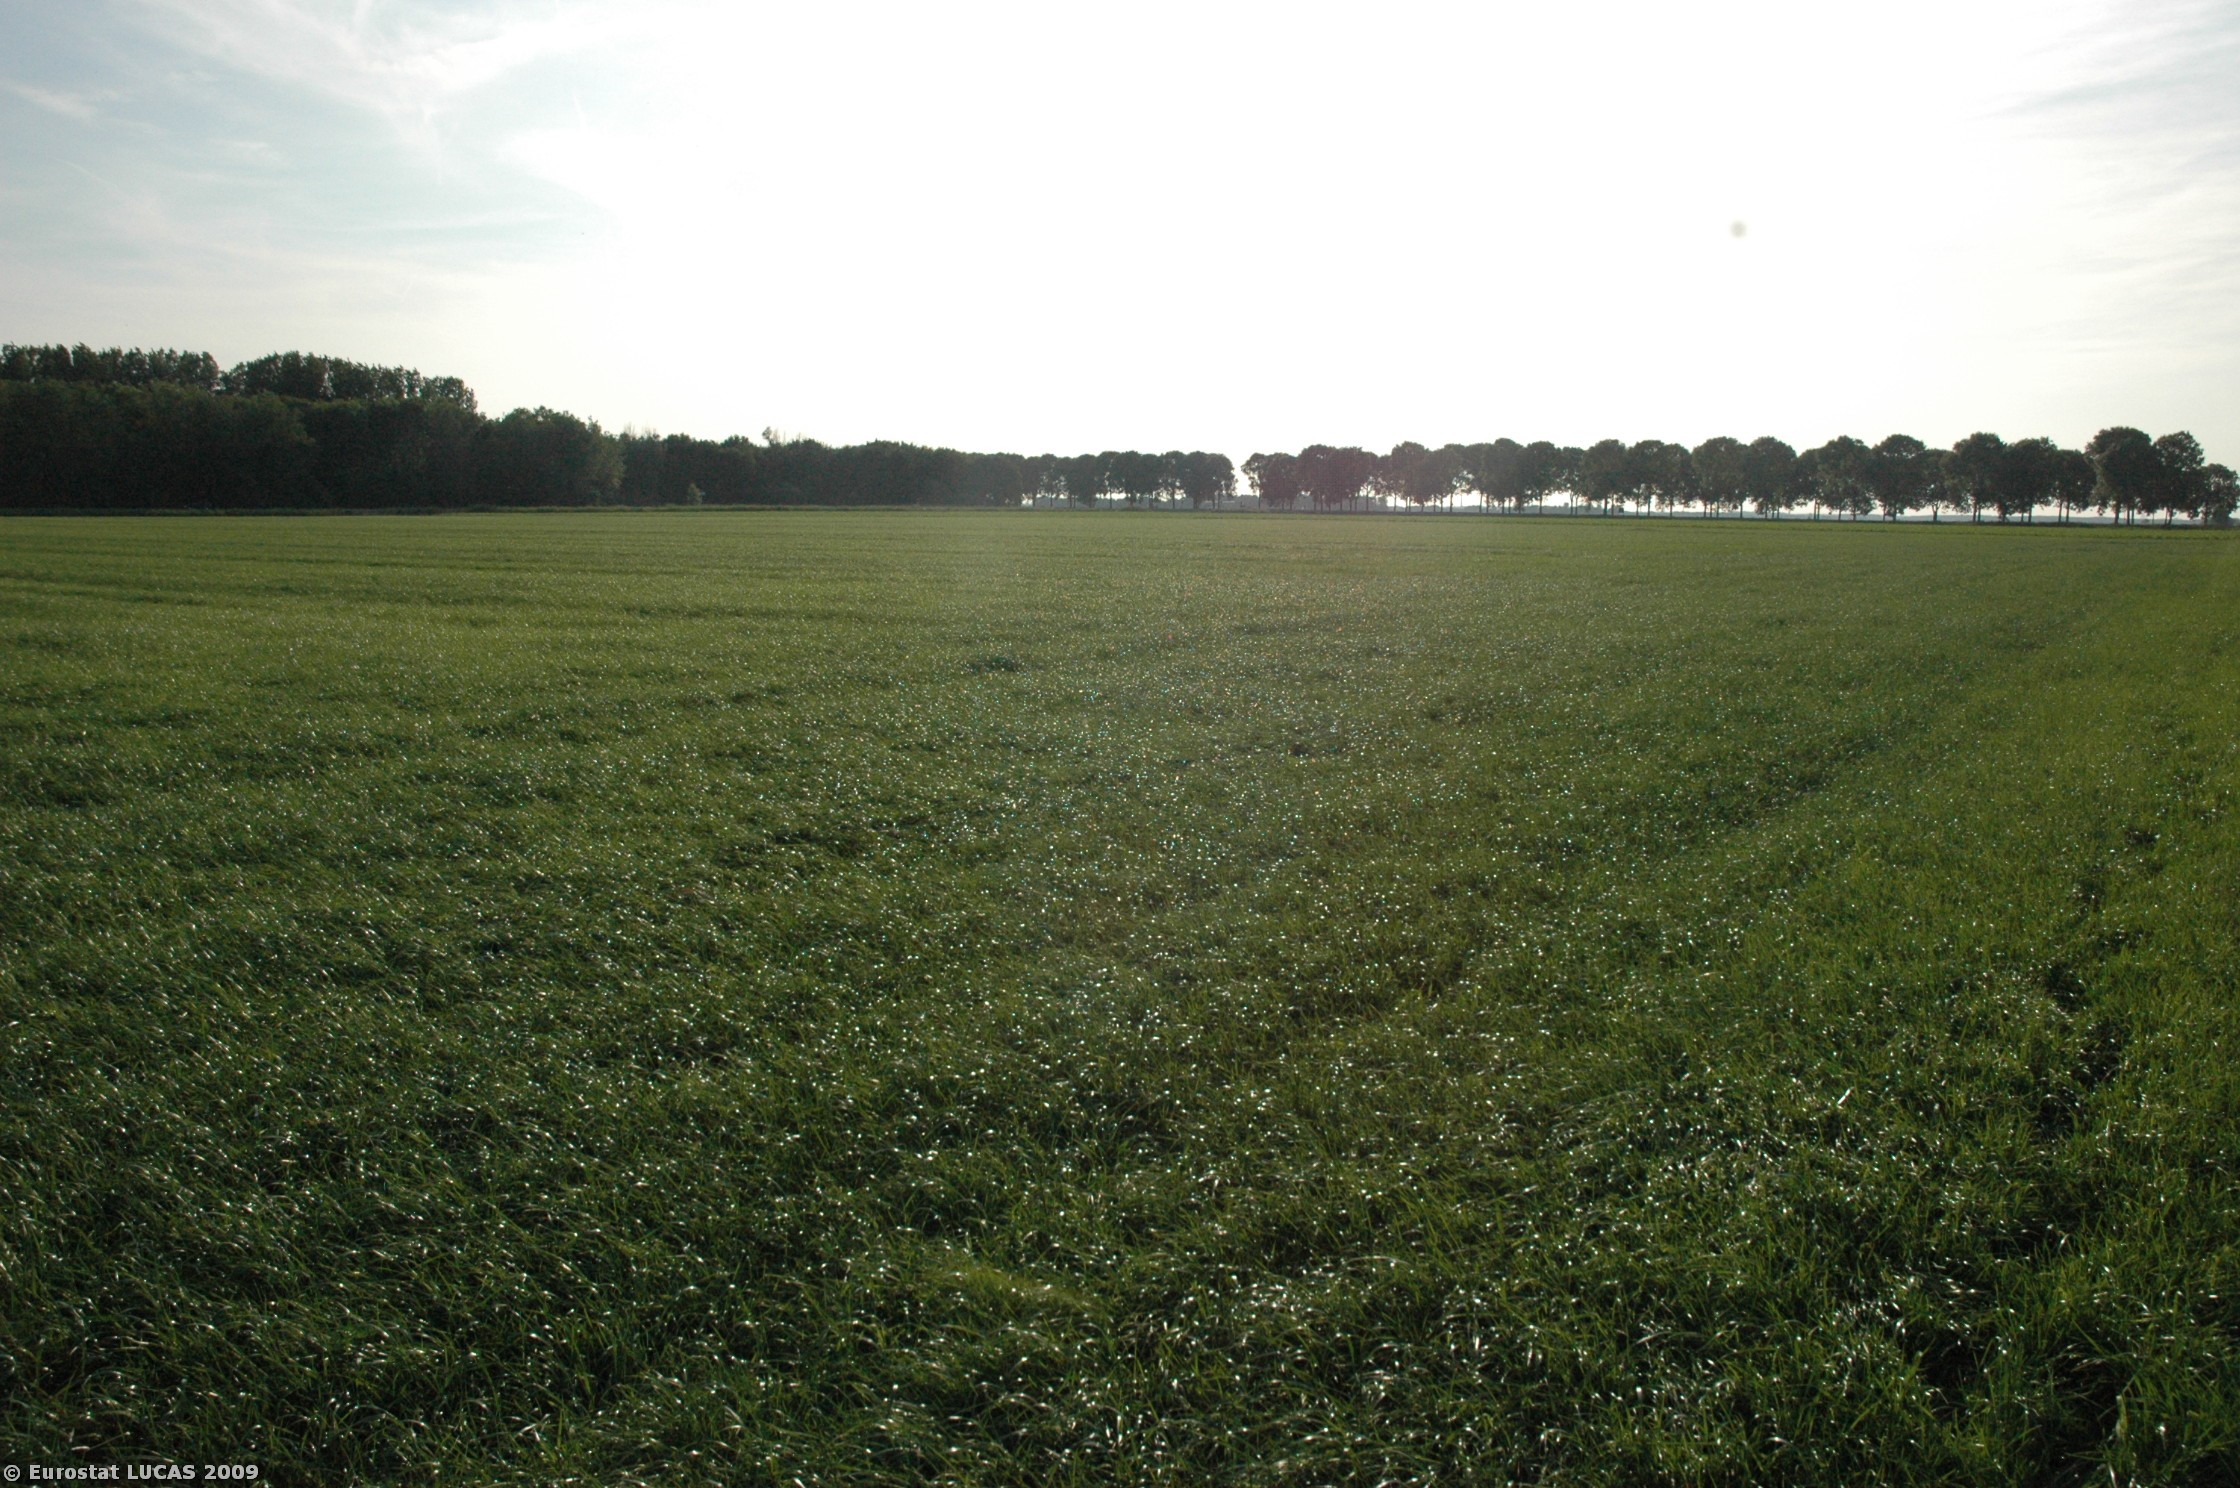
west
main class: Grassland
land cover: Grassland without tree/shrub cover
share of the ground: > 75 %
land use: Agriculture (excluding fallow land and kitchen gardens)
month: June
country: NL
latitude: 52.2708
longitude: 5.4113
